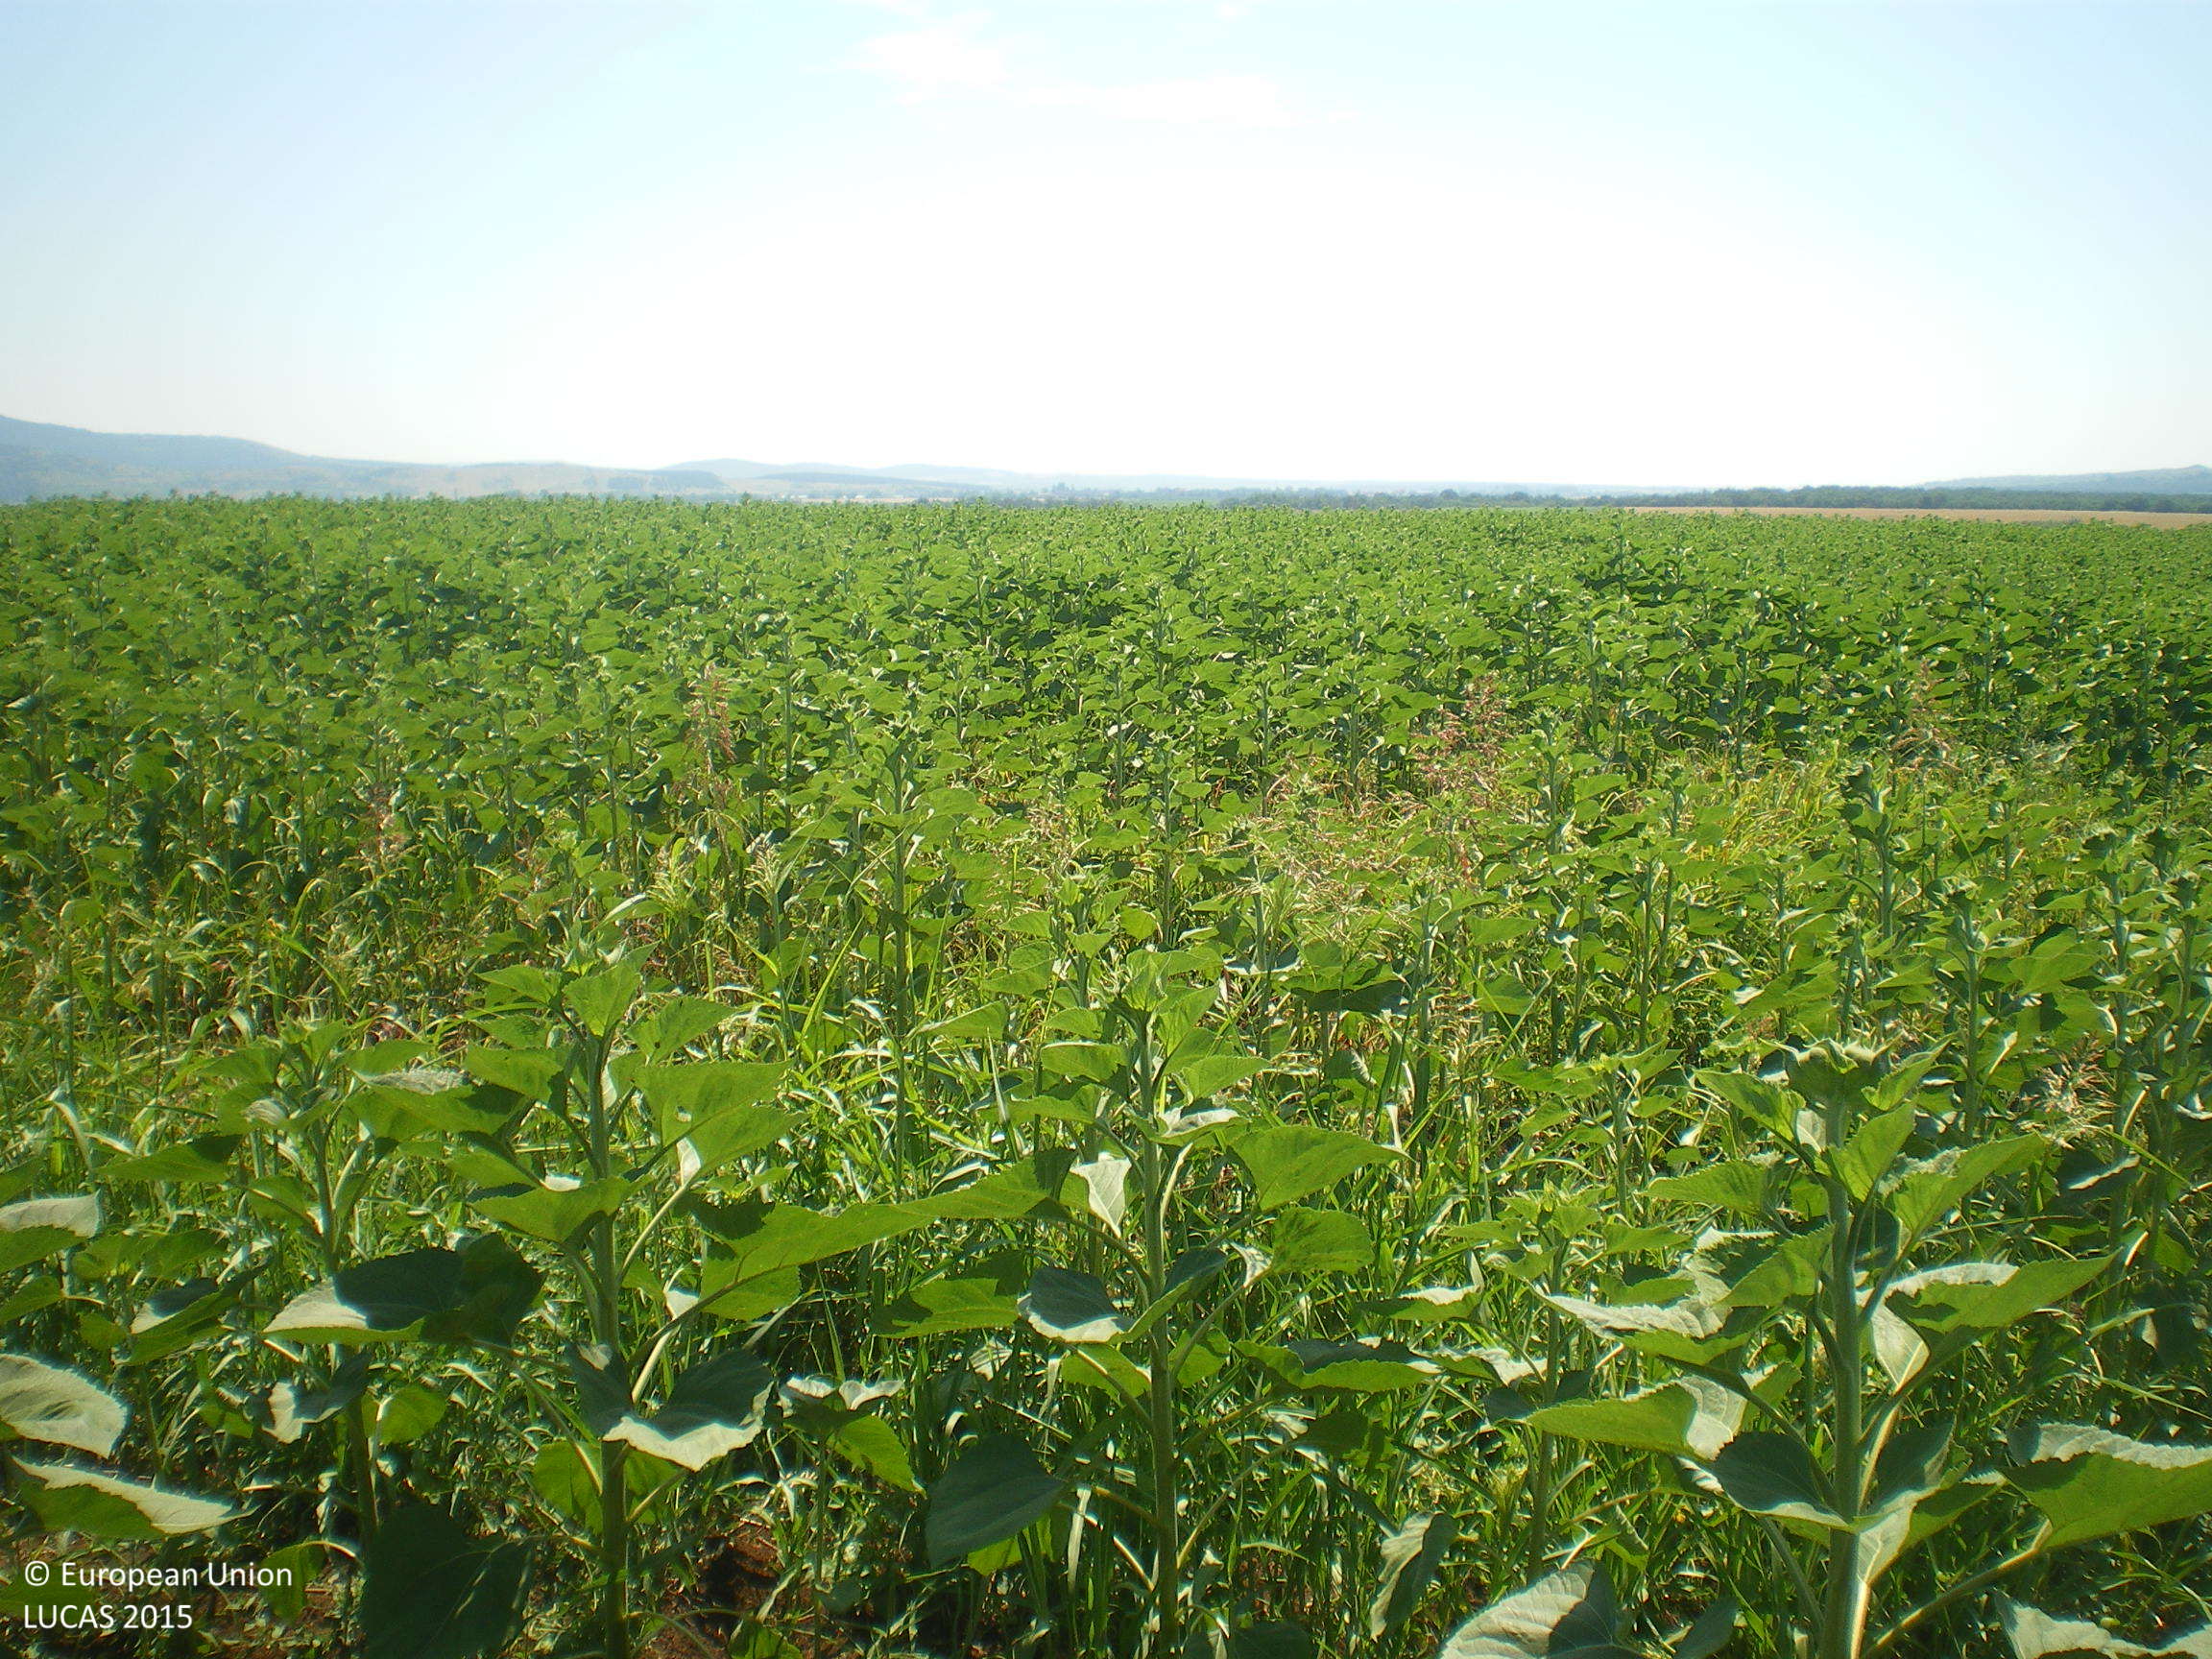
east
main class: Cropland
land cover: Sunflower
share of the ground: 50 - 75 %
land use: Agriculture (excluding fallow land and kitchen gardens)
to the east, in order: Sunflower; Tracks; Barley
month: June
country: BG
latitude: 42.3115
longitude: 25.1657
